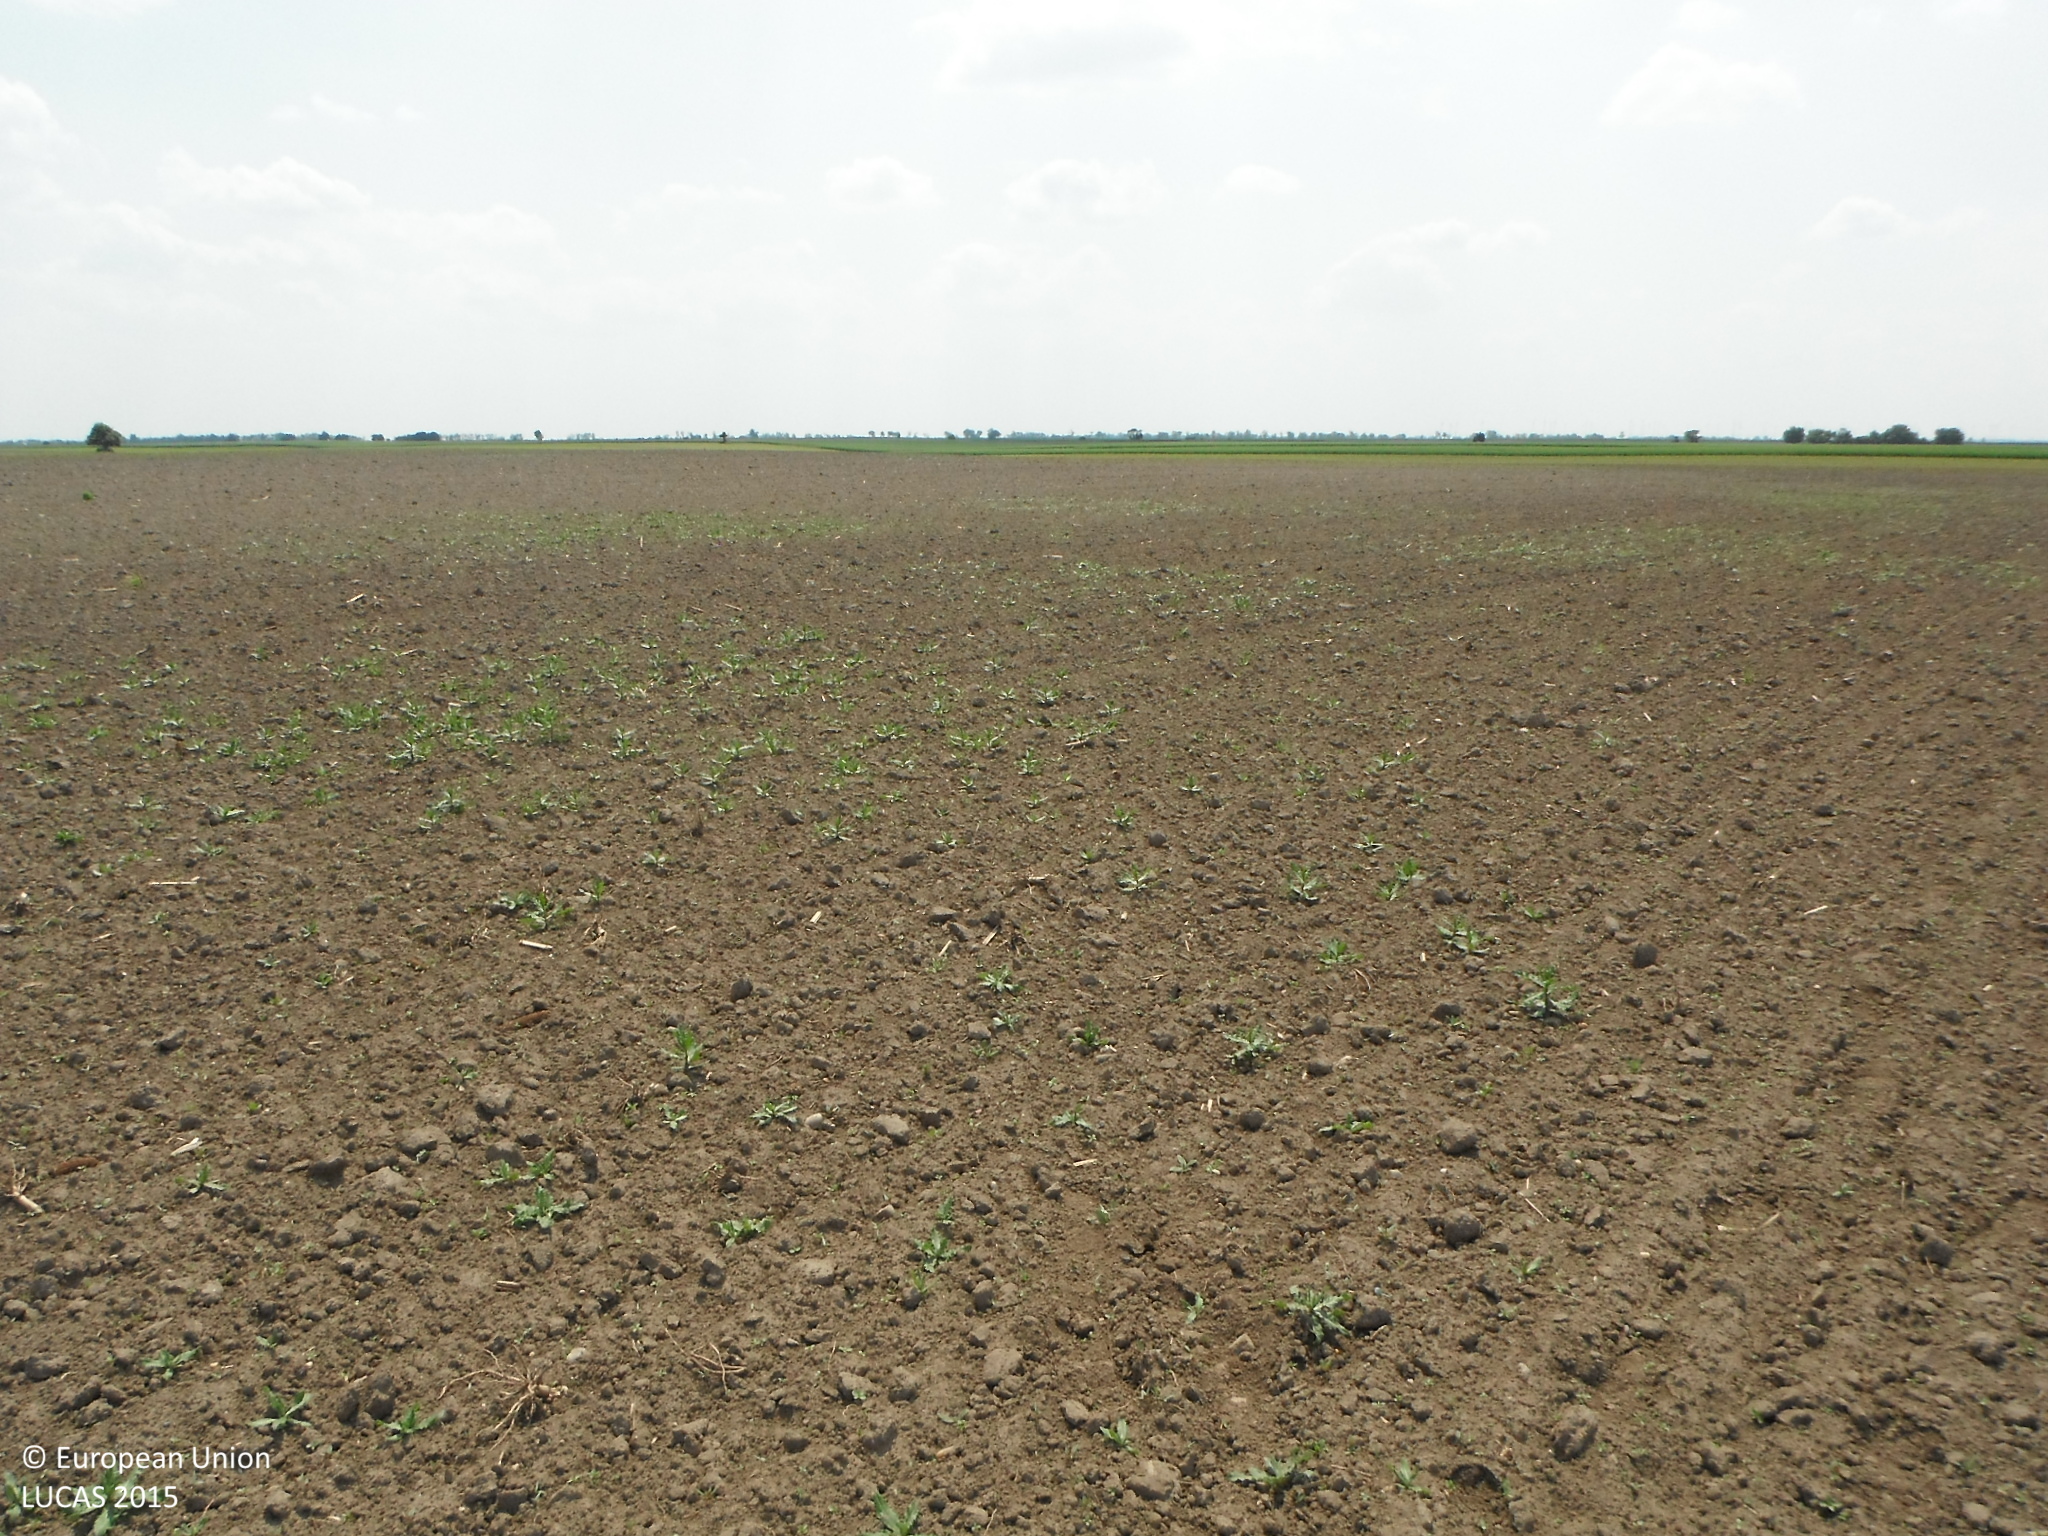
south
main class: Cropland
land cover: Maize
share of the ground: < 10 %
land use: Agriculture (excluding fallow land and kitchen gardens)
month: May
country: SK
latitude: 48.0271
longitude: 17.1551
